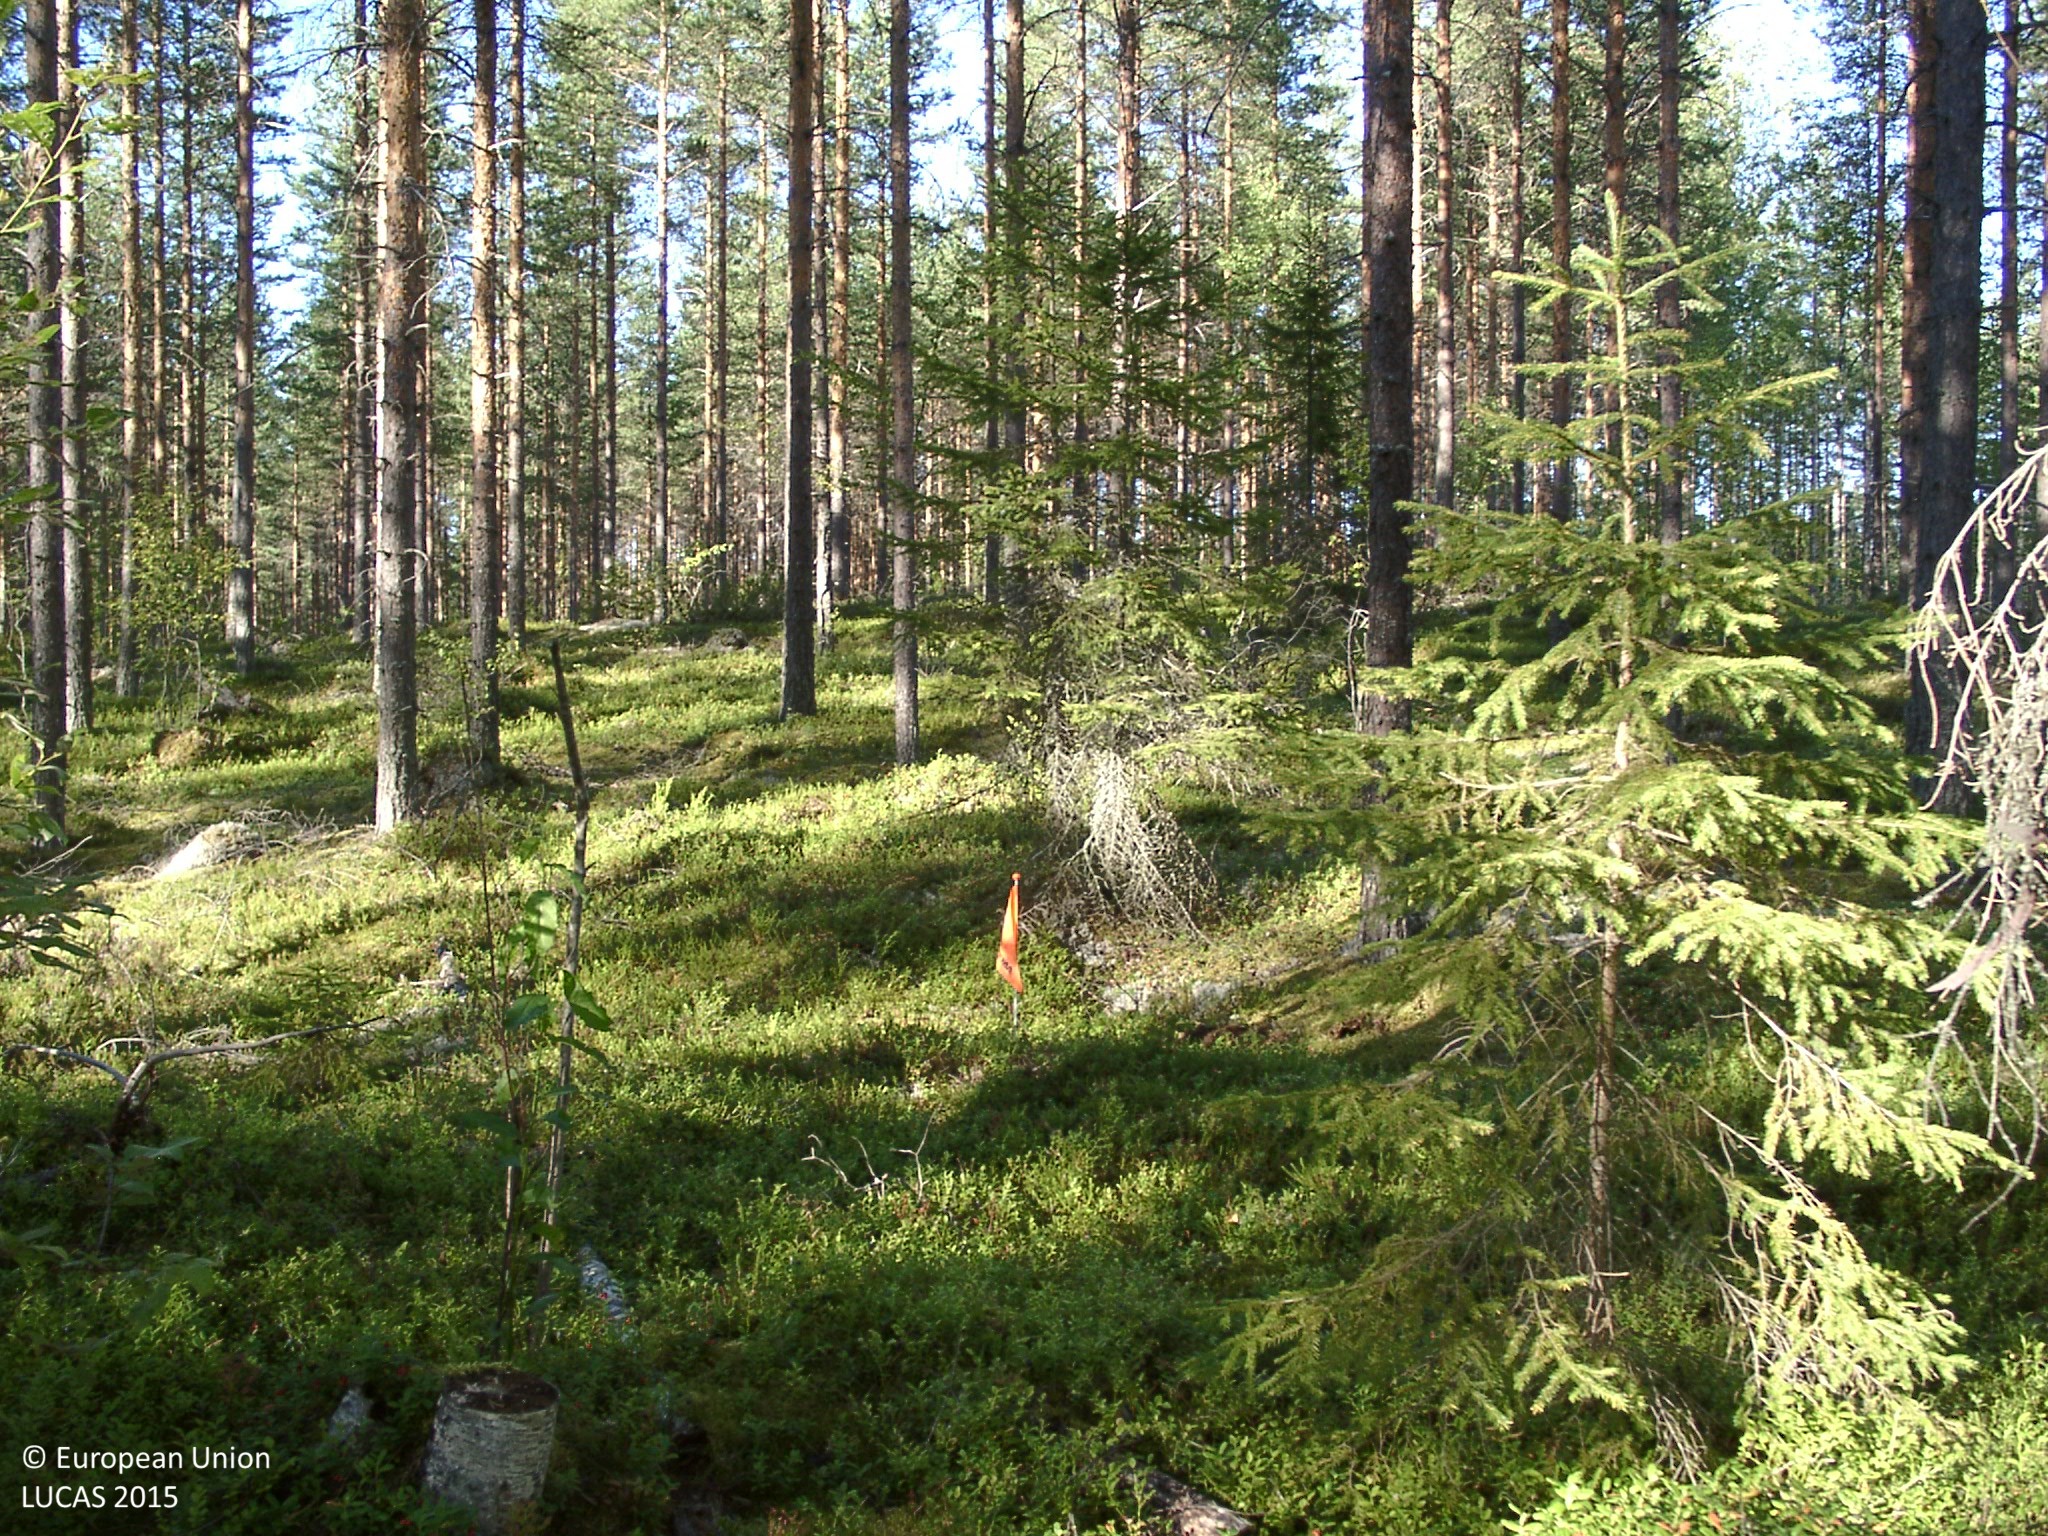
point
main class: Woodland
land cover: Pine dominated coniferous woodland
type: boreal forest
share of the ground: 50 - 75 %
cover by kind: coniferous forest trees 65 %, shrubs 20 %, lichens and mosses 15 %
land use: Forestry
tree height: > 5 m
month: August
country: FI
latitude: 62.4443
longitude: 25.3582
